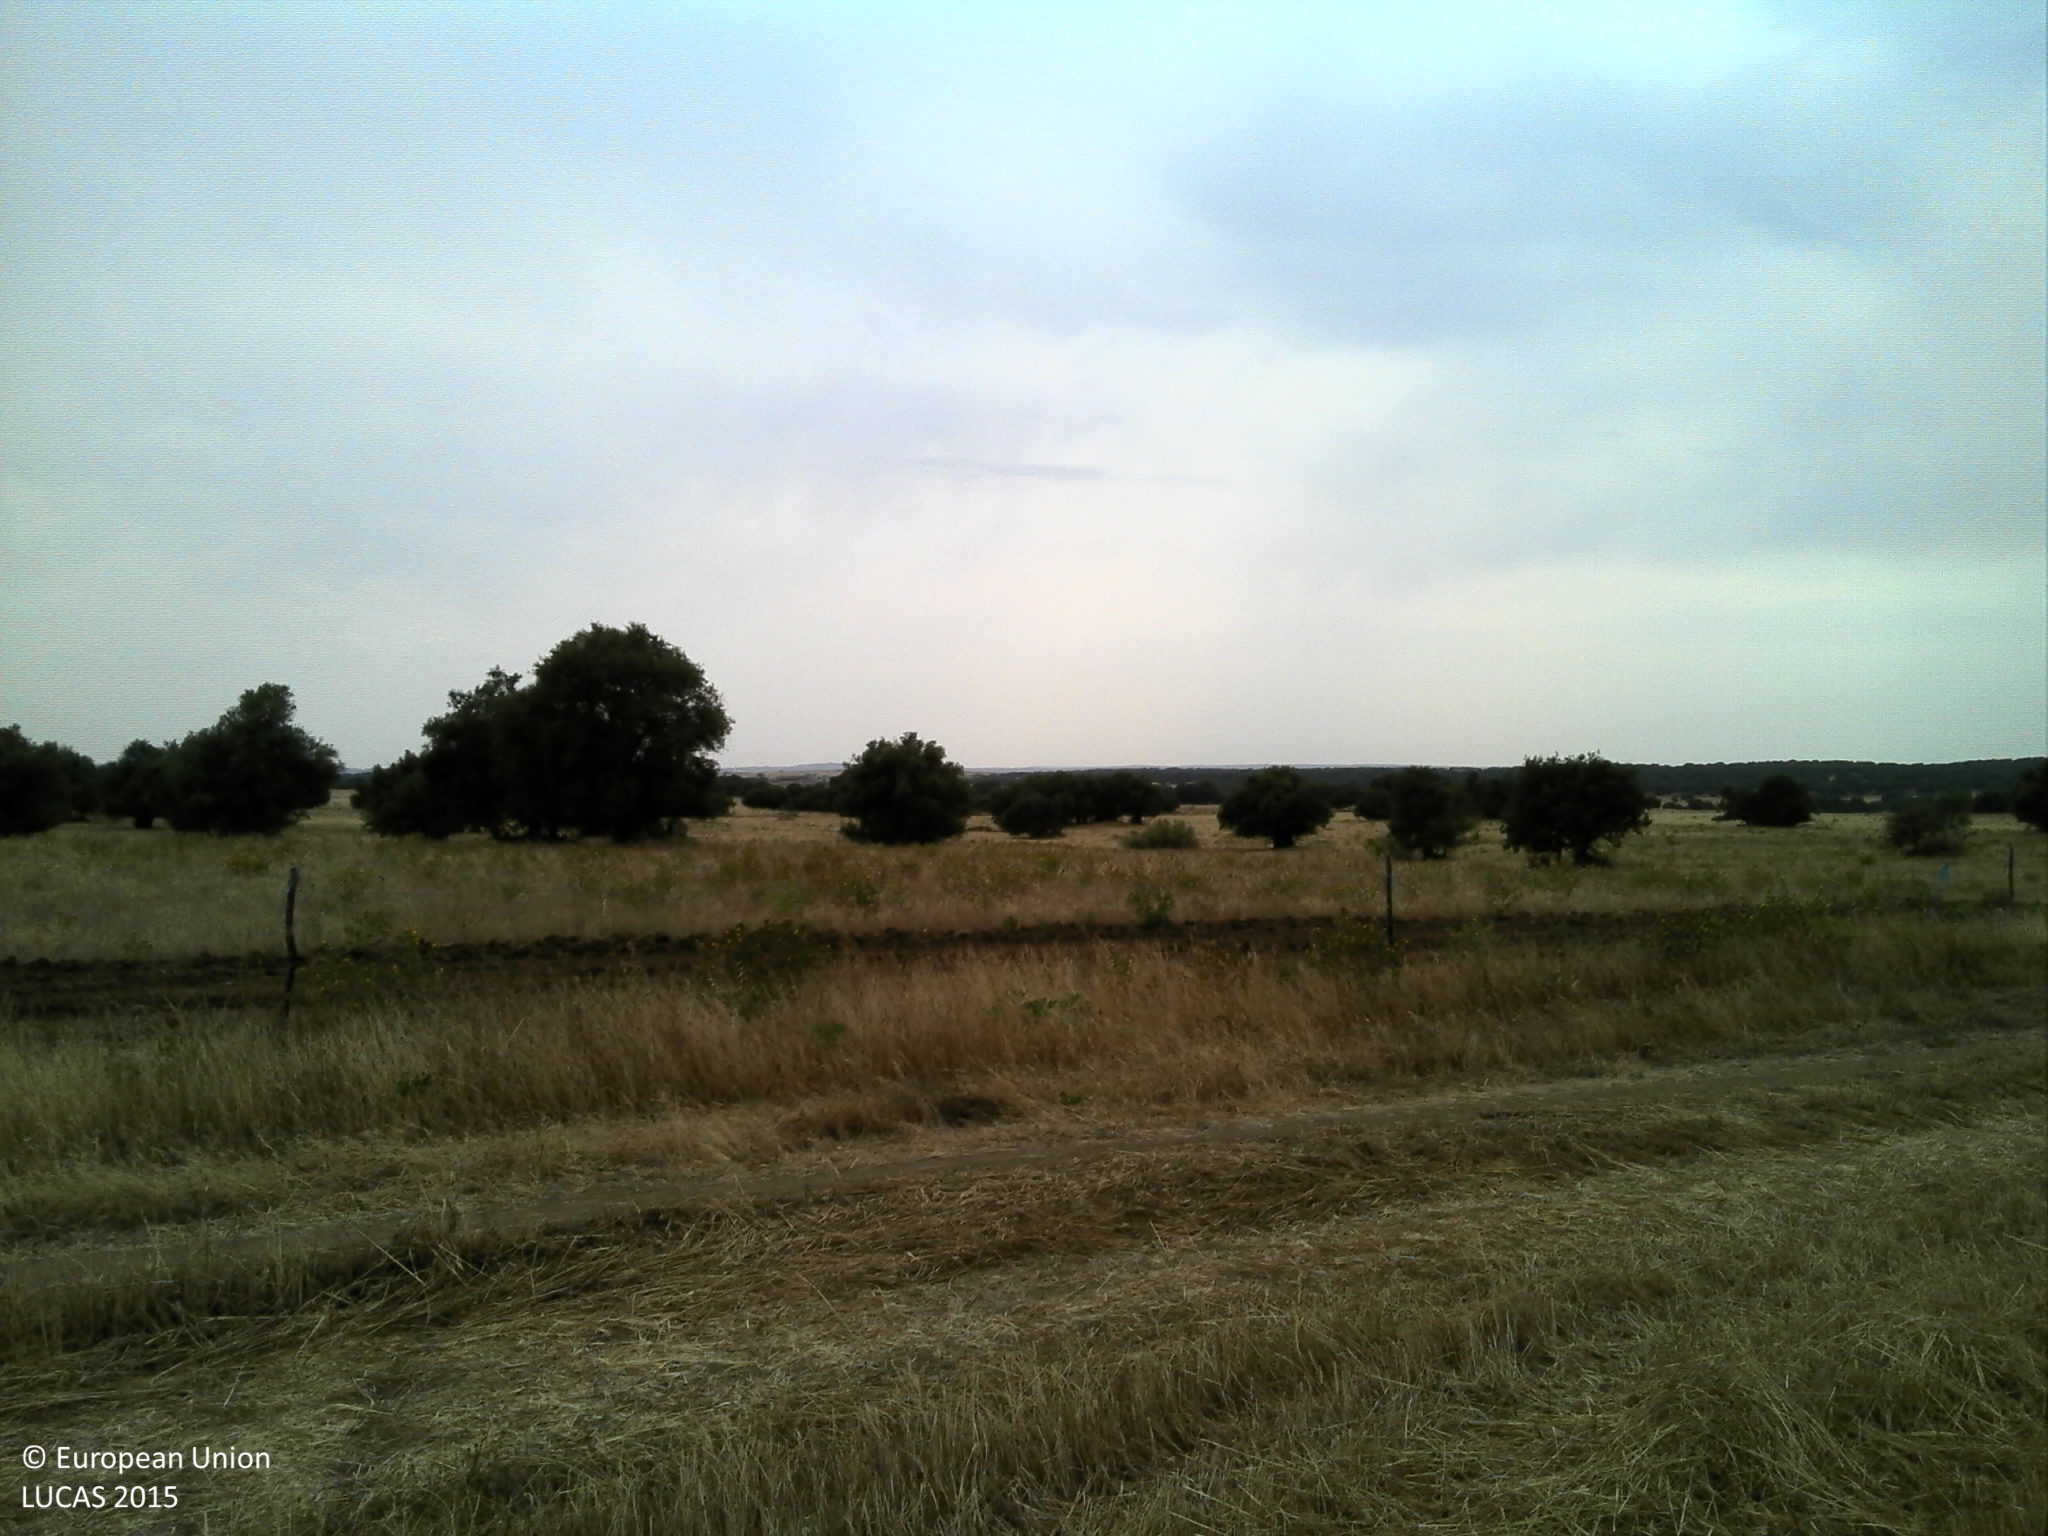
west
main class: Cropland
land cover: Olive groves
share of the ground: 10 - 25 %
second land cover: Mixed cereals for fodder
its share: < 10 %
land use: Agriculture (excluding fallow land and kitchen gardens)
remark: Harvested field
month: June
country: PT
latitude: 38.6670
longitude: -7.7717
